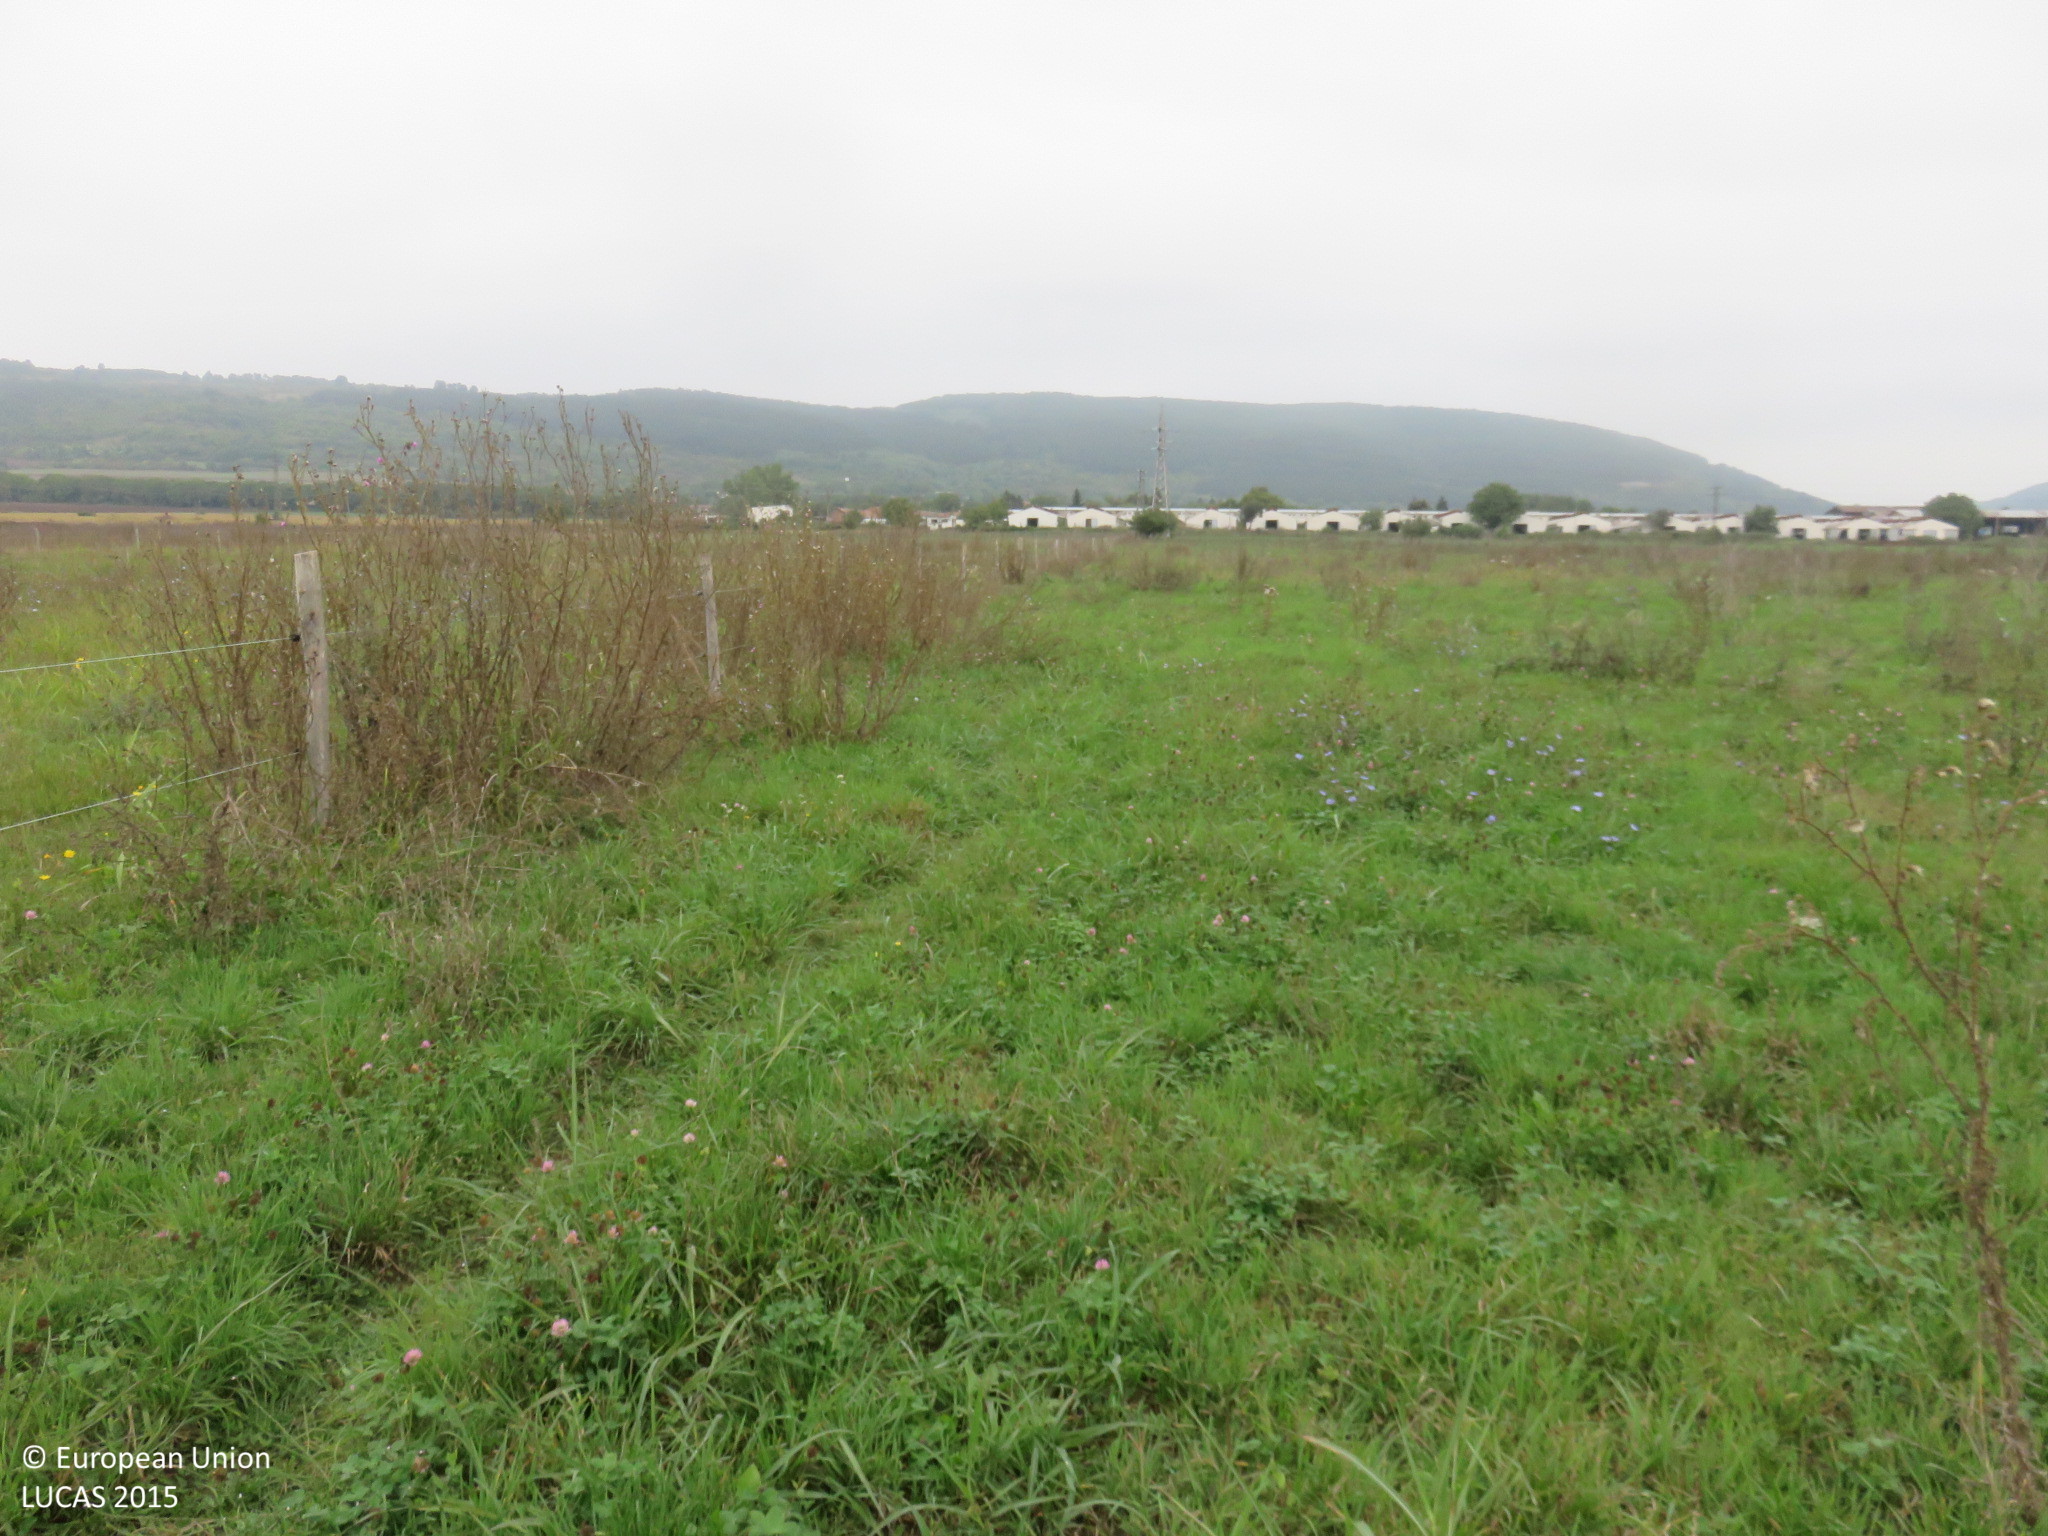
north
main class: Grassland
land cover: Grassland without tree/shrub cover
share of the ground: > 75 %
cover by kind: herbaceous plants 100 %
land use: Agriculture (excluding fallow land and kitchen gardens)
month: September
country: BG
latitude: 43.0466
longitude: 25.0314
